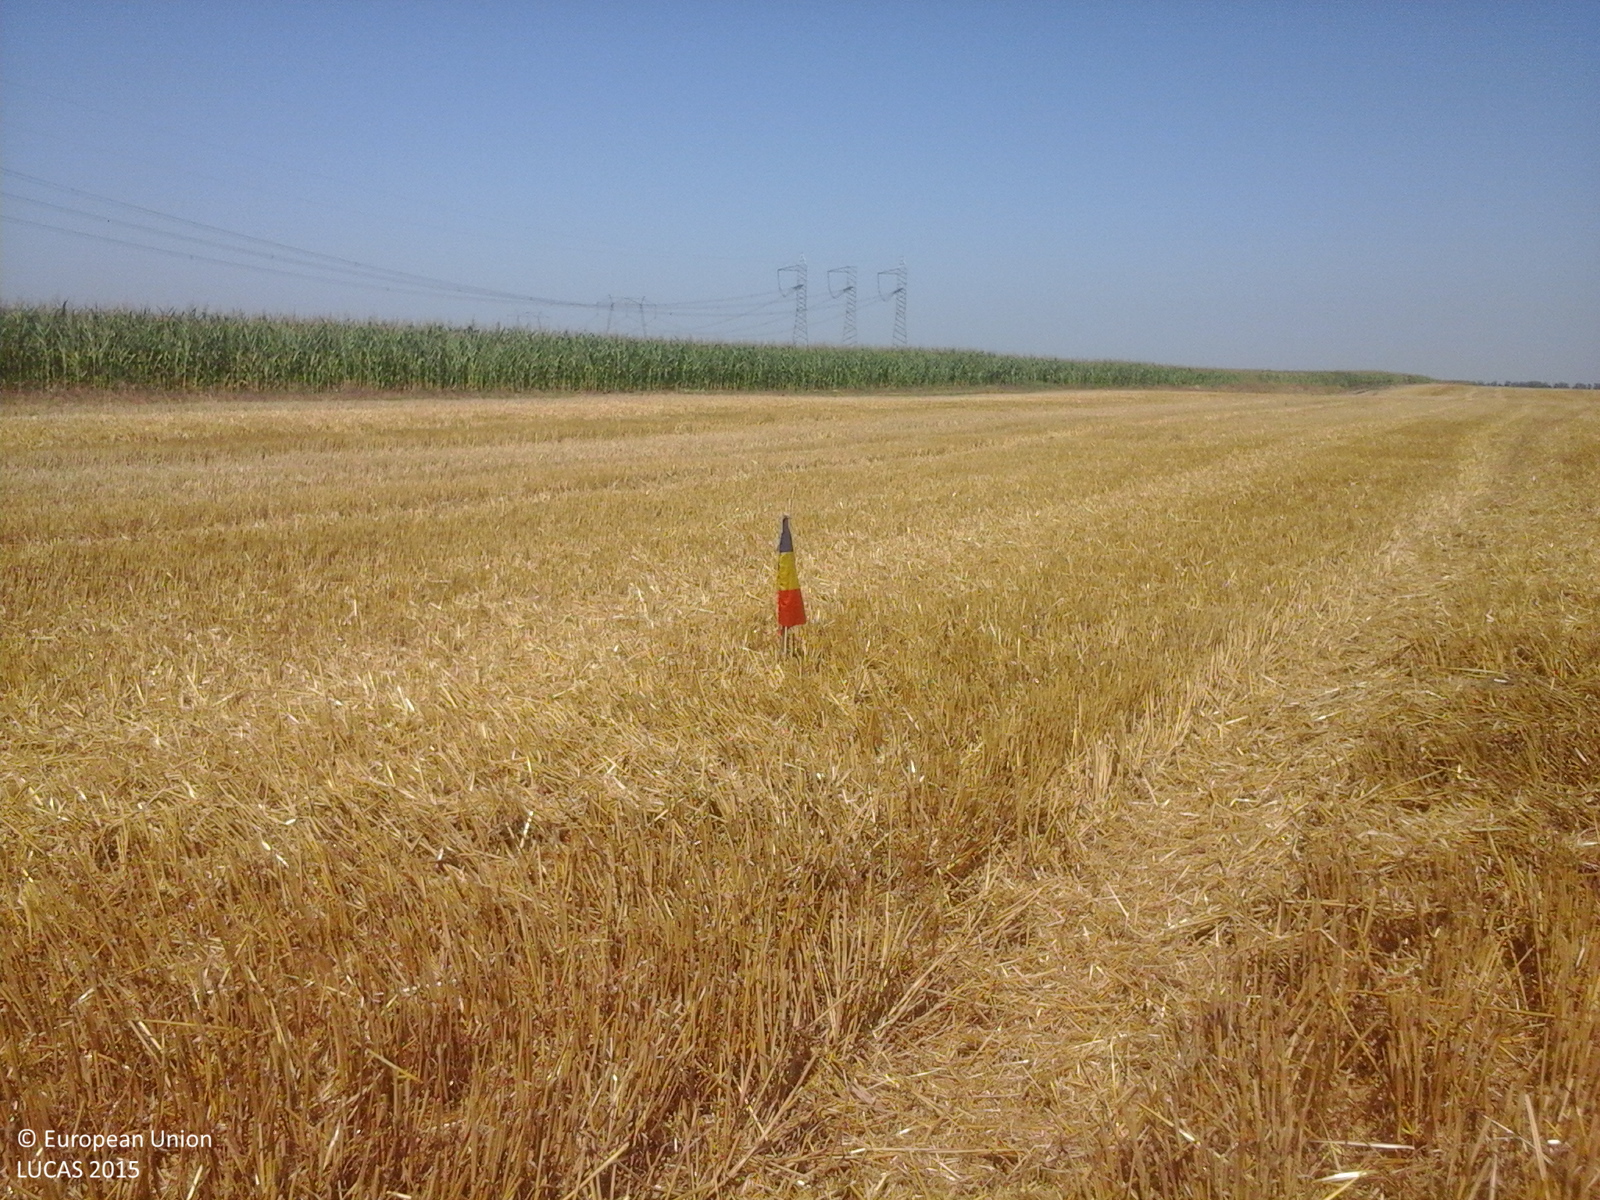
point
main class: Cropland
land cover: Durum wheat
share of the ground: 50 - 75 %
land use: Agriculture (excluding fallow land and kitchen gardens)
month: July
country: RO
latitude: 44.2116
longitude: 26.6236
